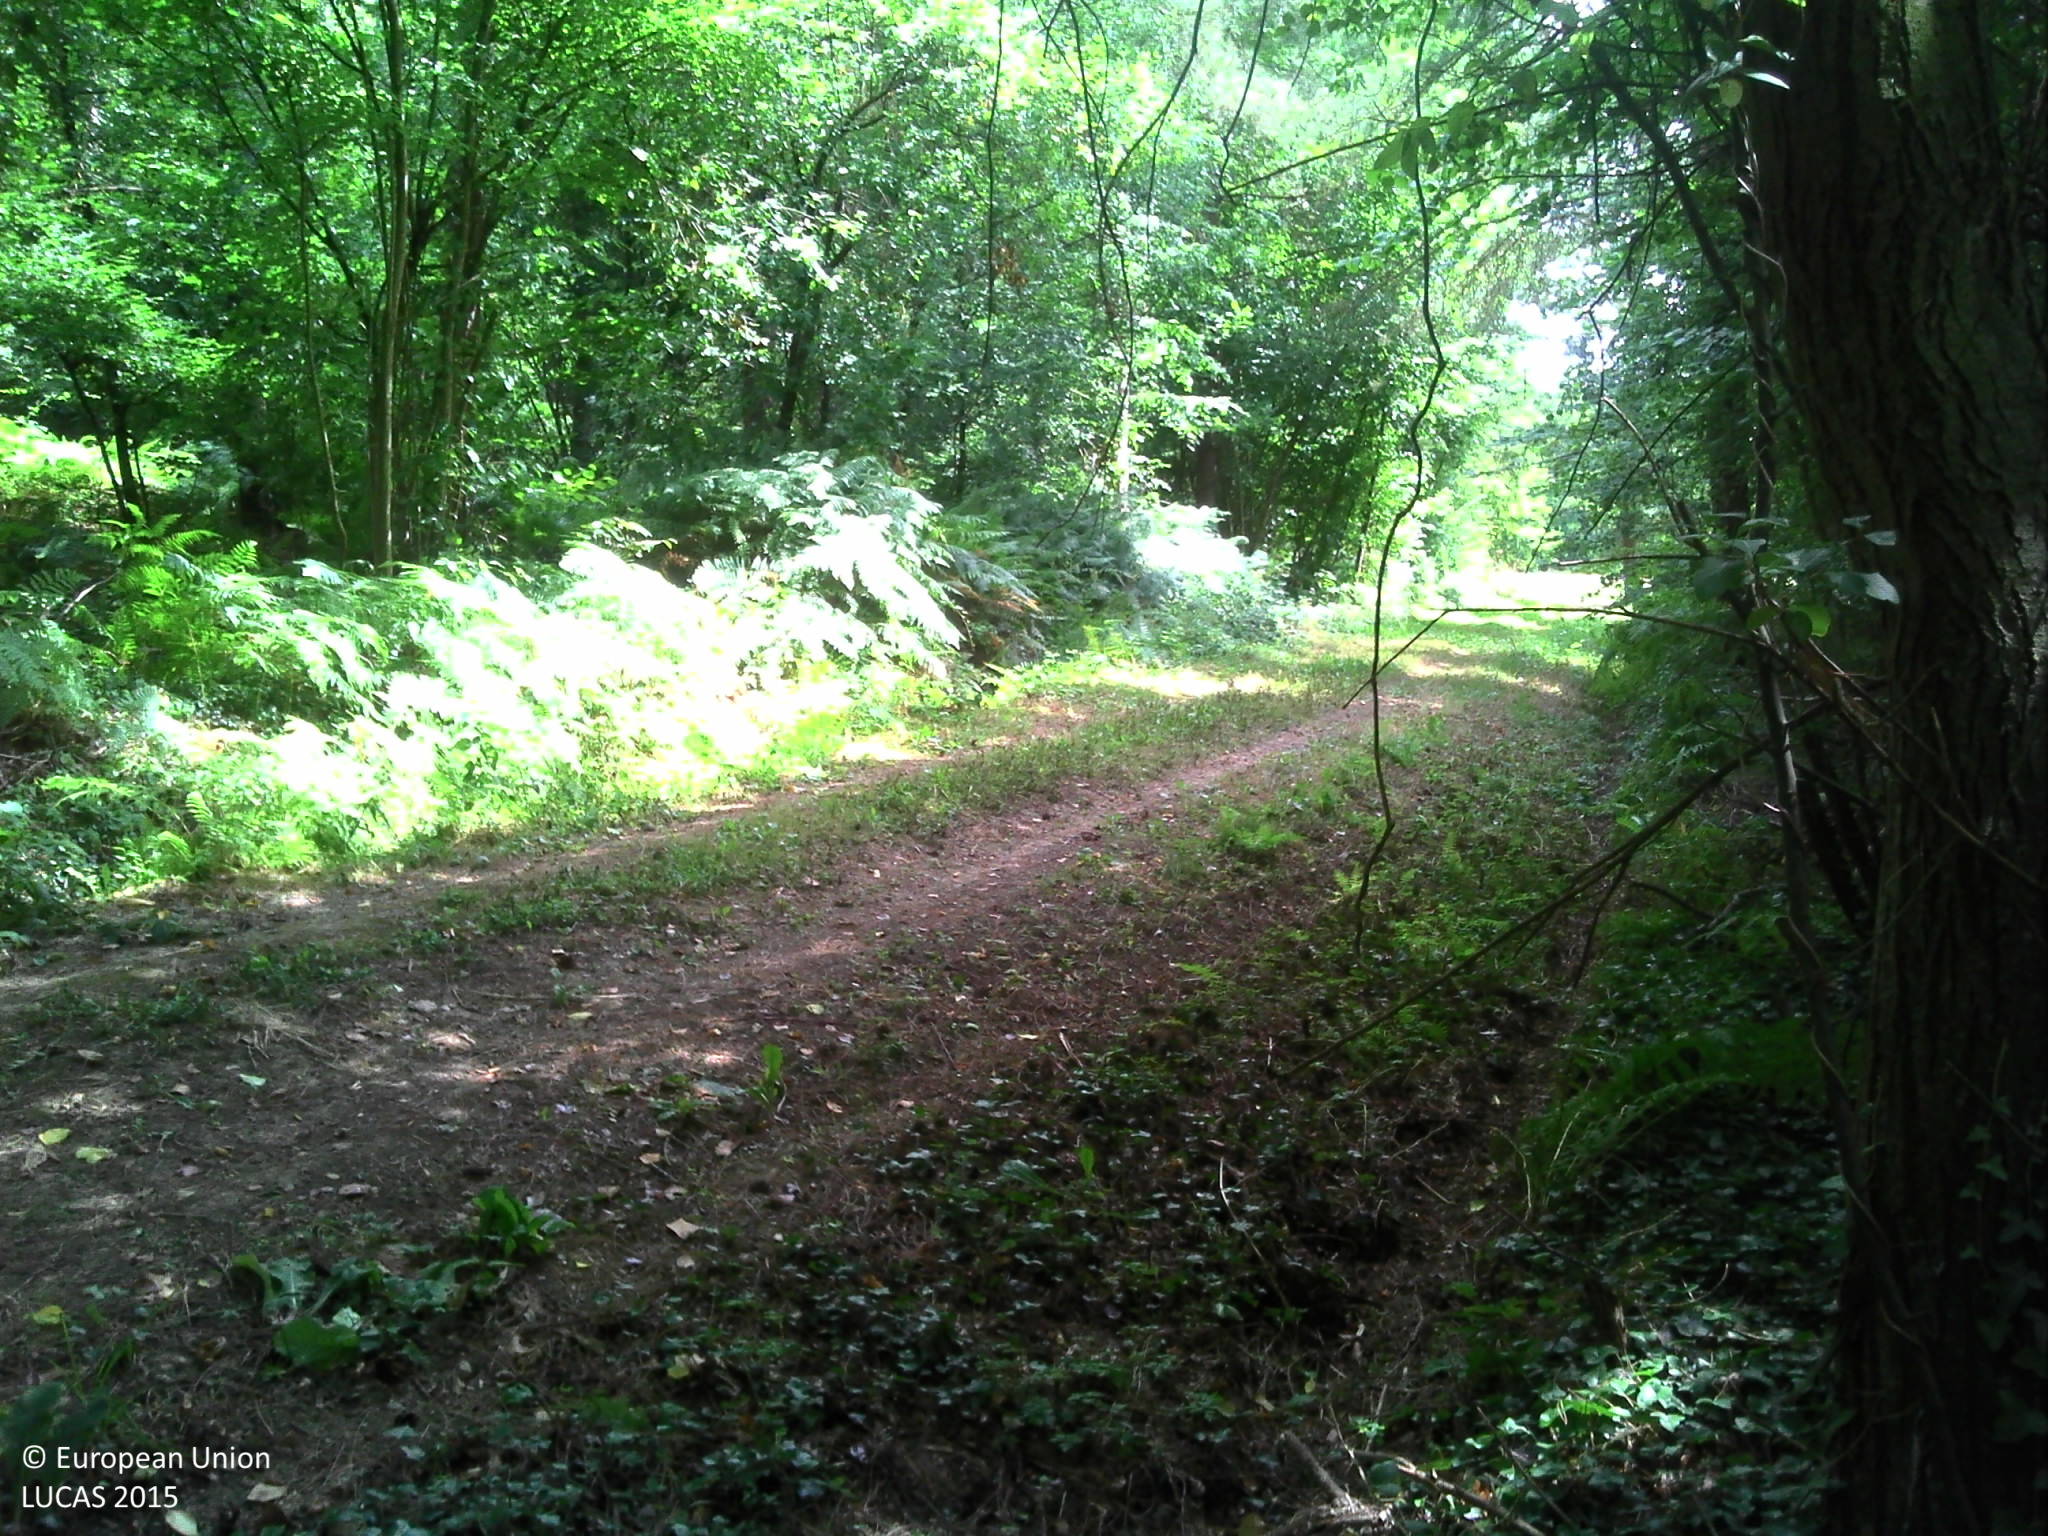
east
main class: Woodland
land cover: Broadleaved woodland
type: mesophytic deciduous forest
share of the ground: > 75 %
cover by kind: broadleaved forest trees 95 %, coniferous forest trees 5 %
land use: Forestry
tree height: > 5 m
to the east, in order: Broadleaved woodland; Ditches and canals; Tracks; Ditches and canals; Broadleaved woodland; Ditches and canals; Tracks; Ditches and canals; Pine dominated mixed woodland; Tracks; Pine dominated mixed woodland; Ditches and canals; Tracks; Ditches and canals; Pine dominated mixed woodland
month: August
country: FR
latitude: 46.7794
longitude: -1.3669
